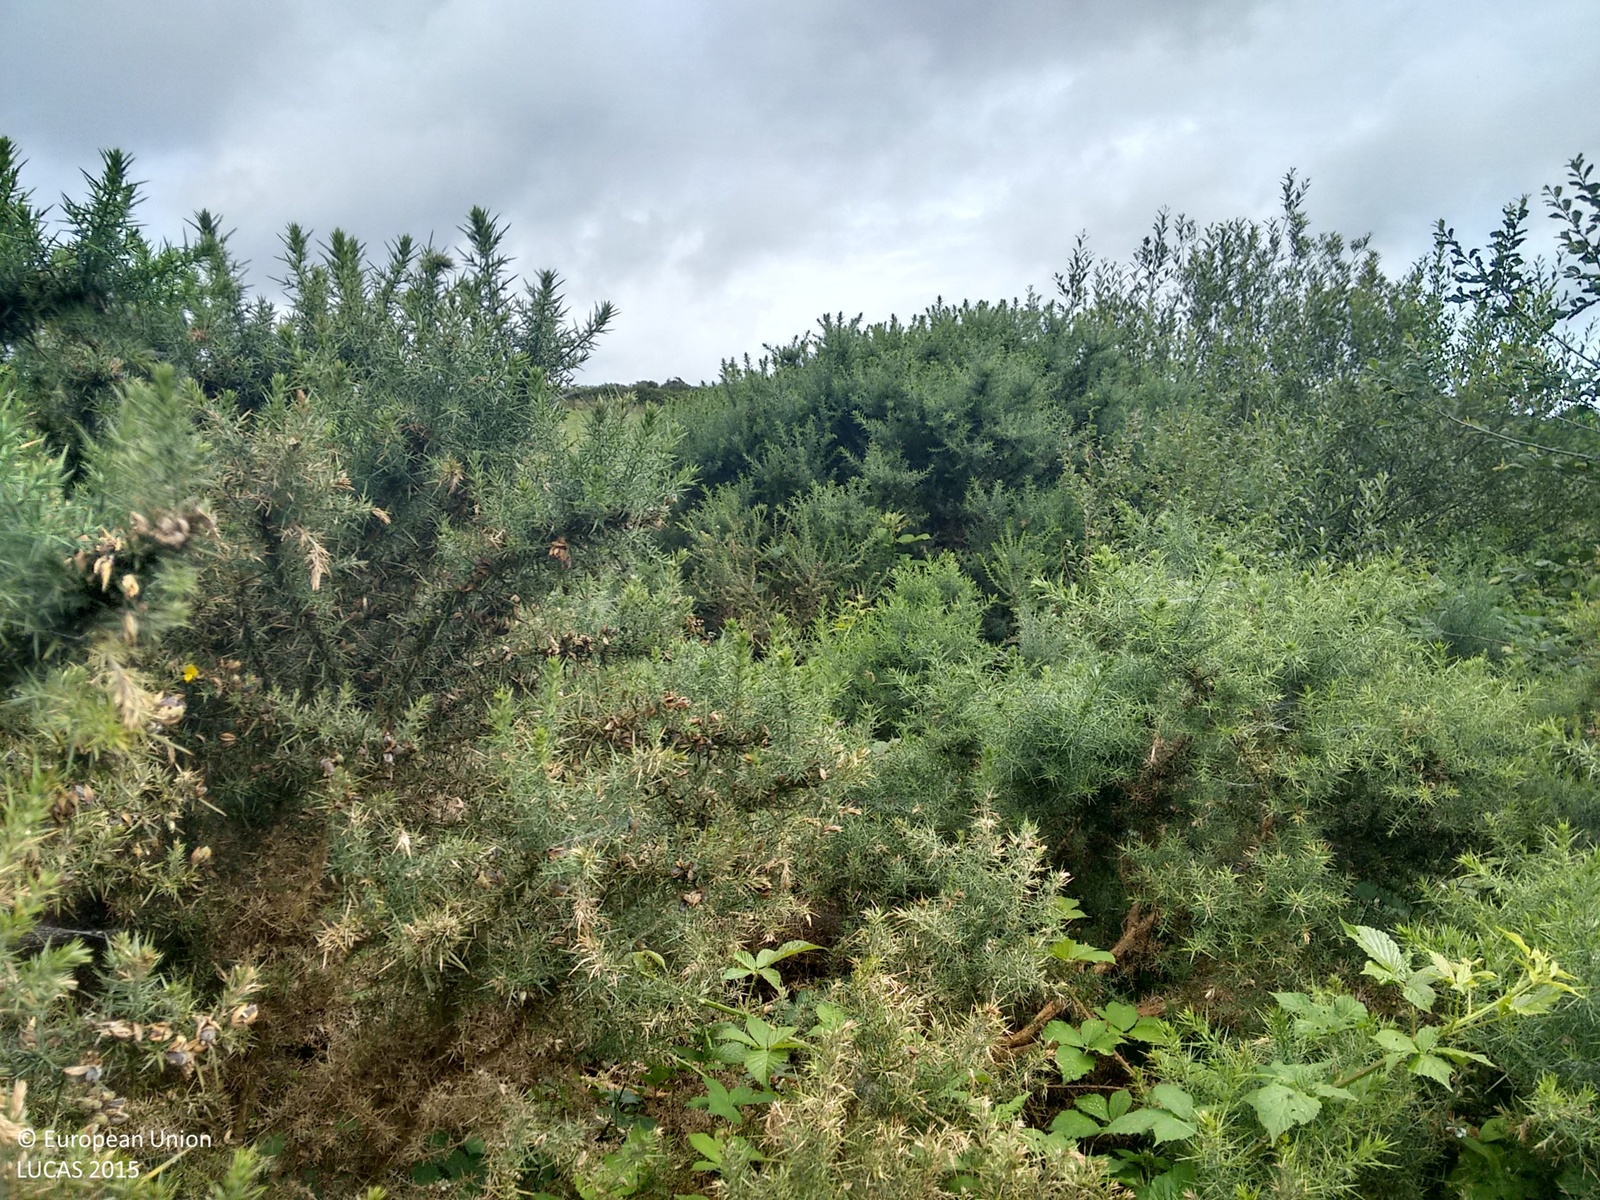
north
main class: Shrubland
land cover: Shrubland with sparse tree cover
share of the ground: > 75 %
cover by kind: shrubs 90 %, broadleaved forest trees 5 %, herbaceous plants 5 %
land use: Abandoned areas
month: July
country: IE
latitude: 51.6702
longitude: -9.2365
